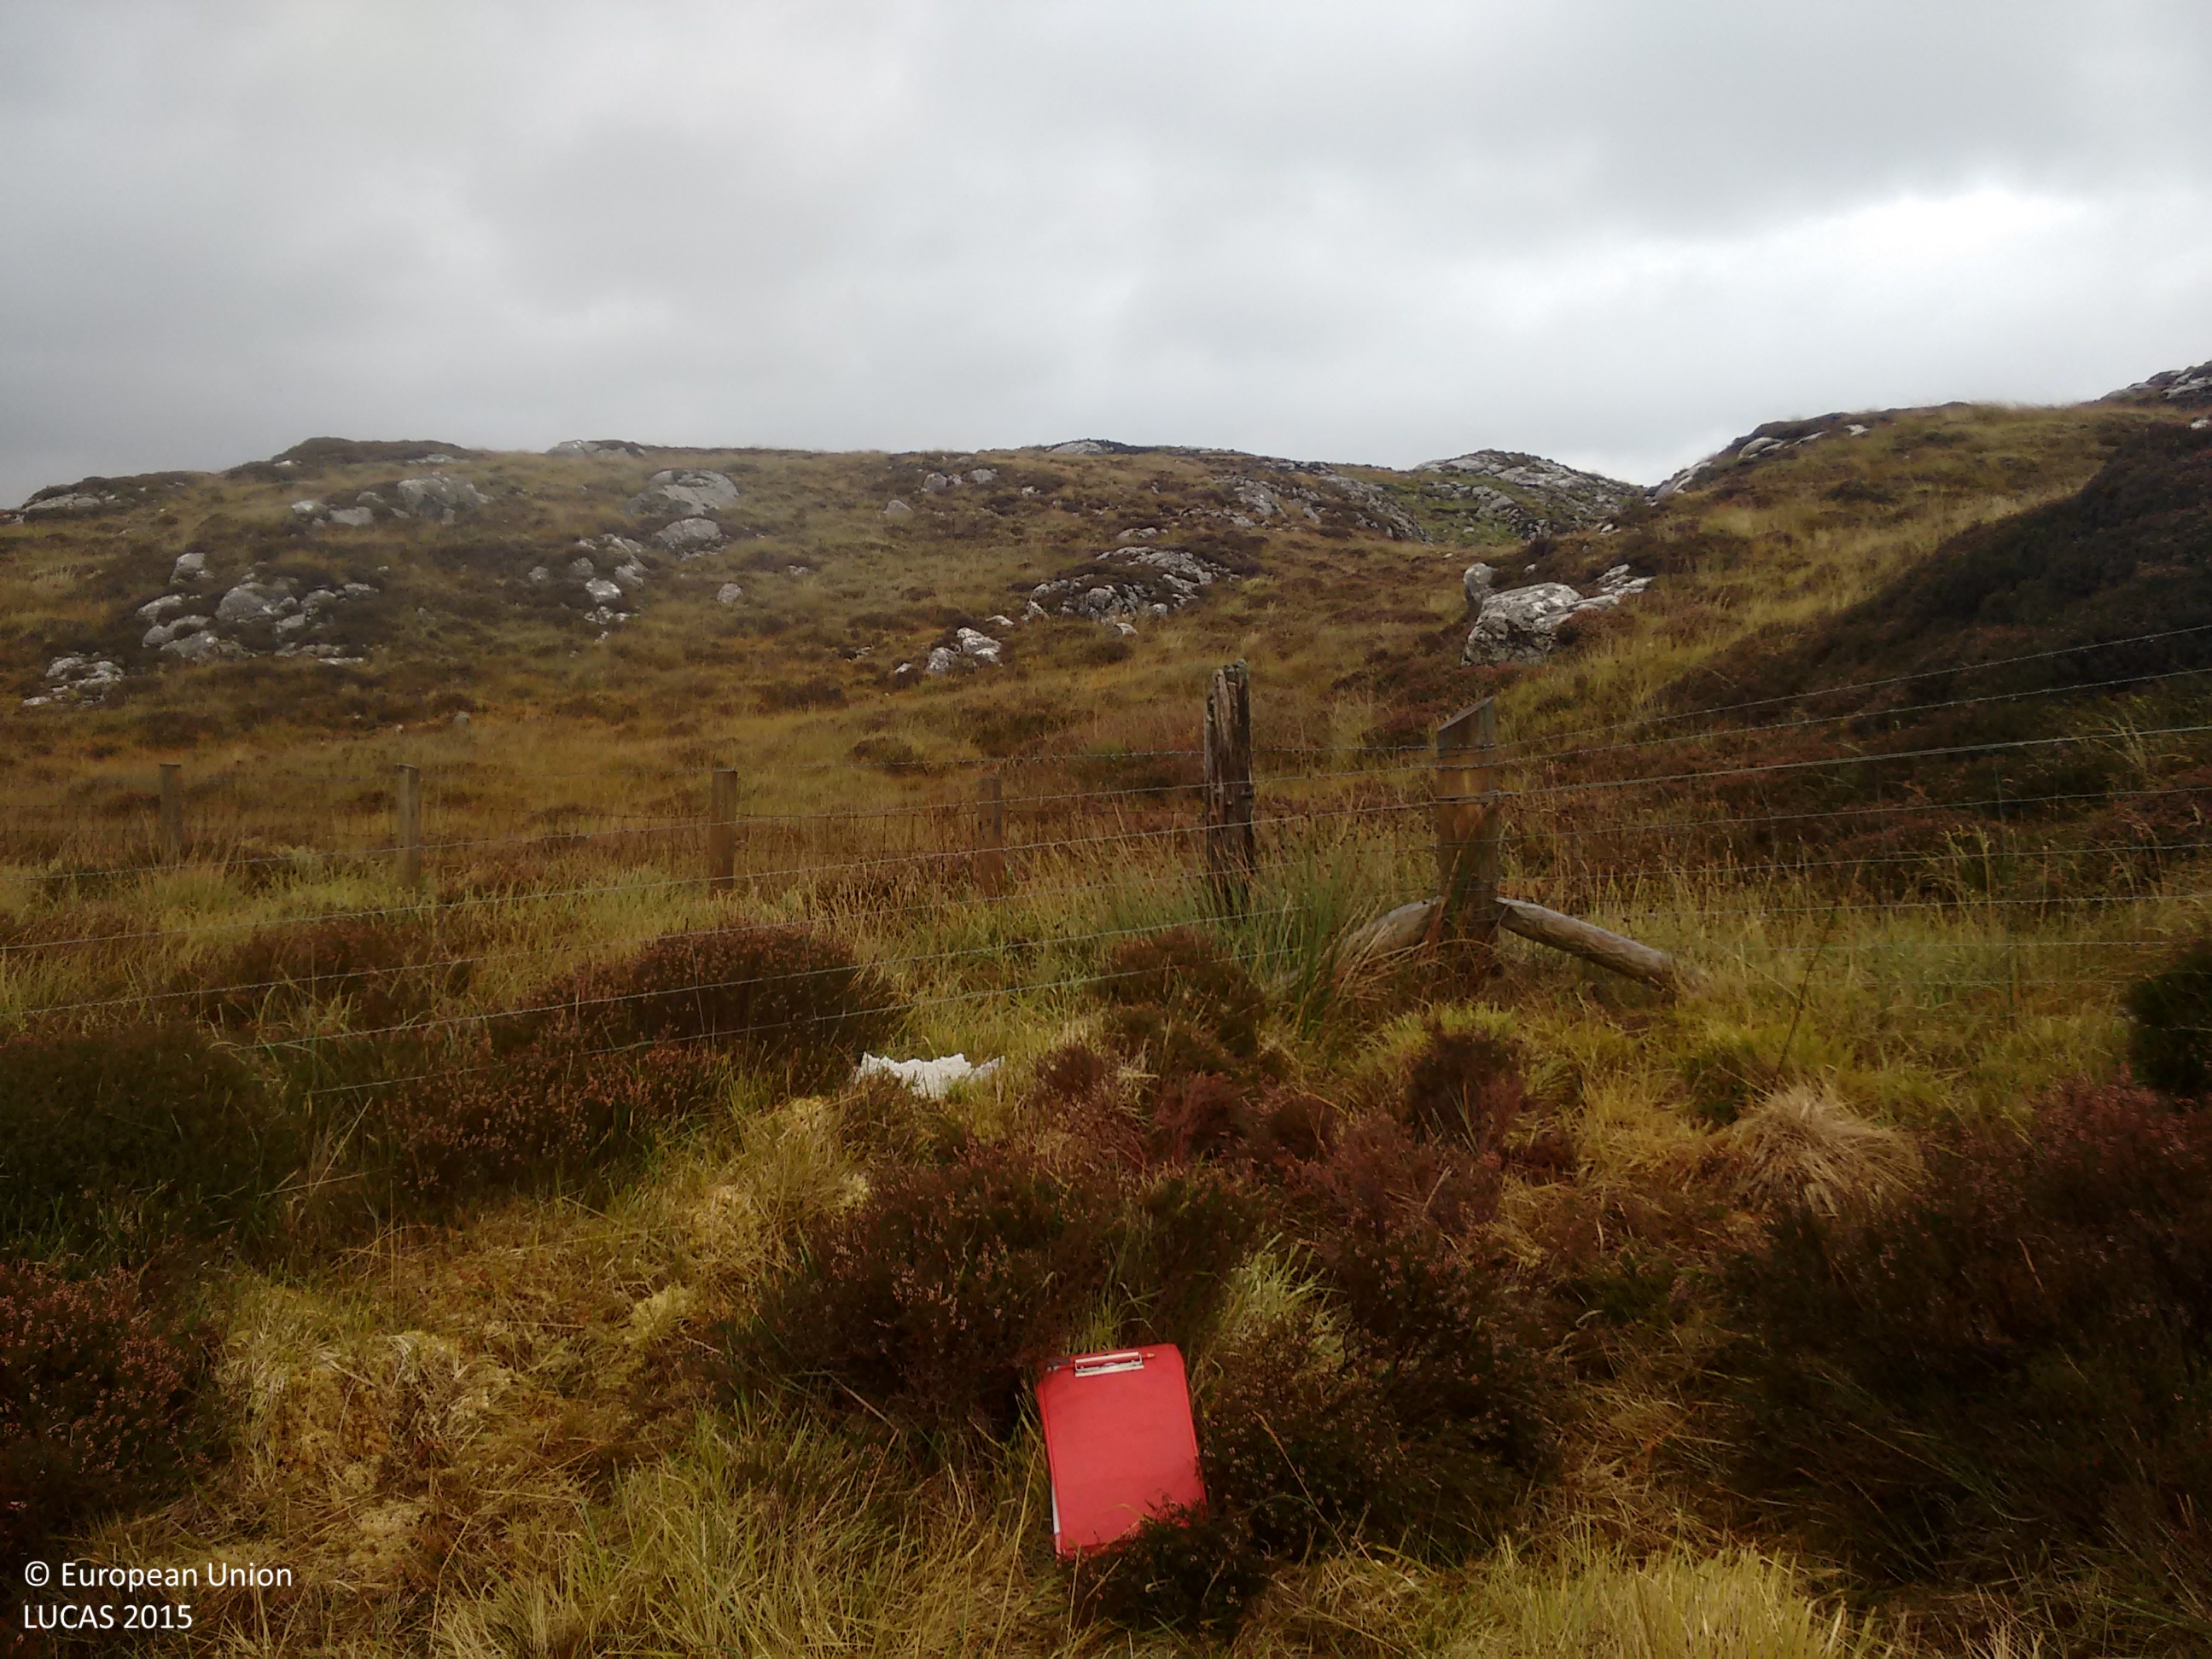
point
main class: Shrubland
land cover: Shrubland without tree cover
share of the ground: > 75 %
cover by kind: herbaceous plants 60 %, shrubs 40 %
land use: Agriculture (excluding fallow land and kitchen gardens)
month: October
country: GB
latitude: 58.1419
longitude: -6.3915
